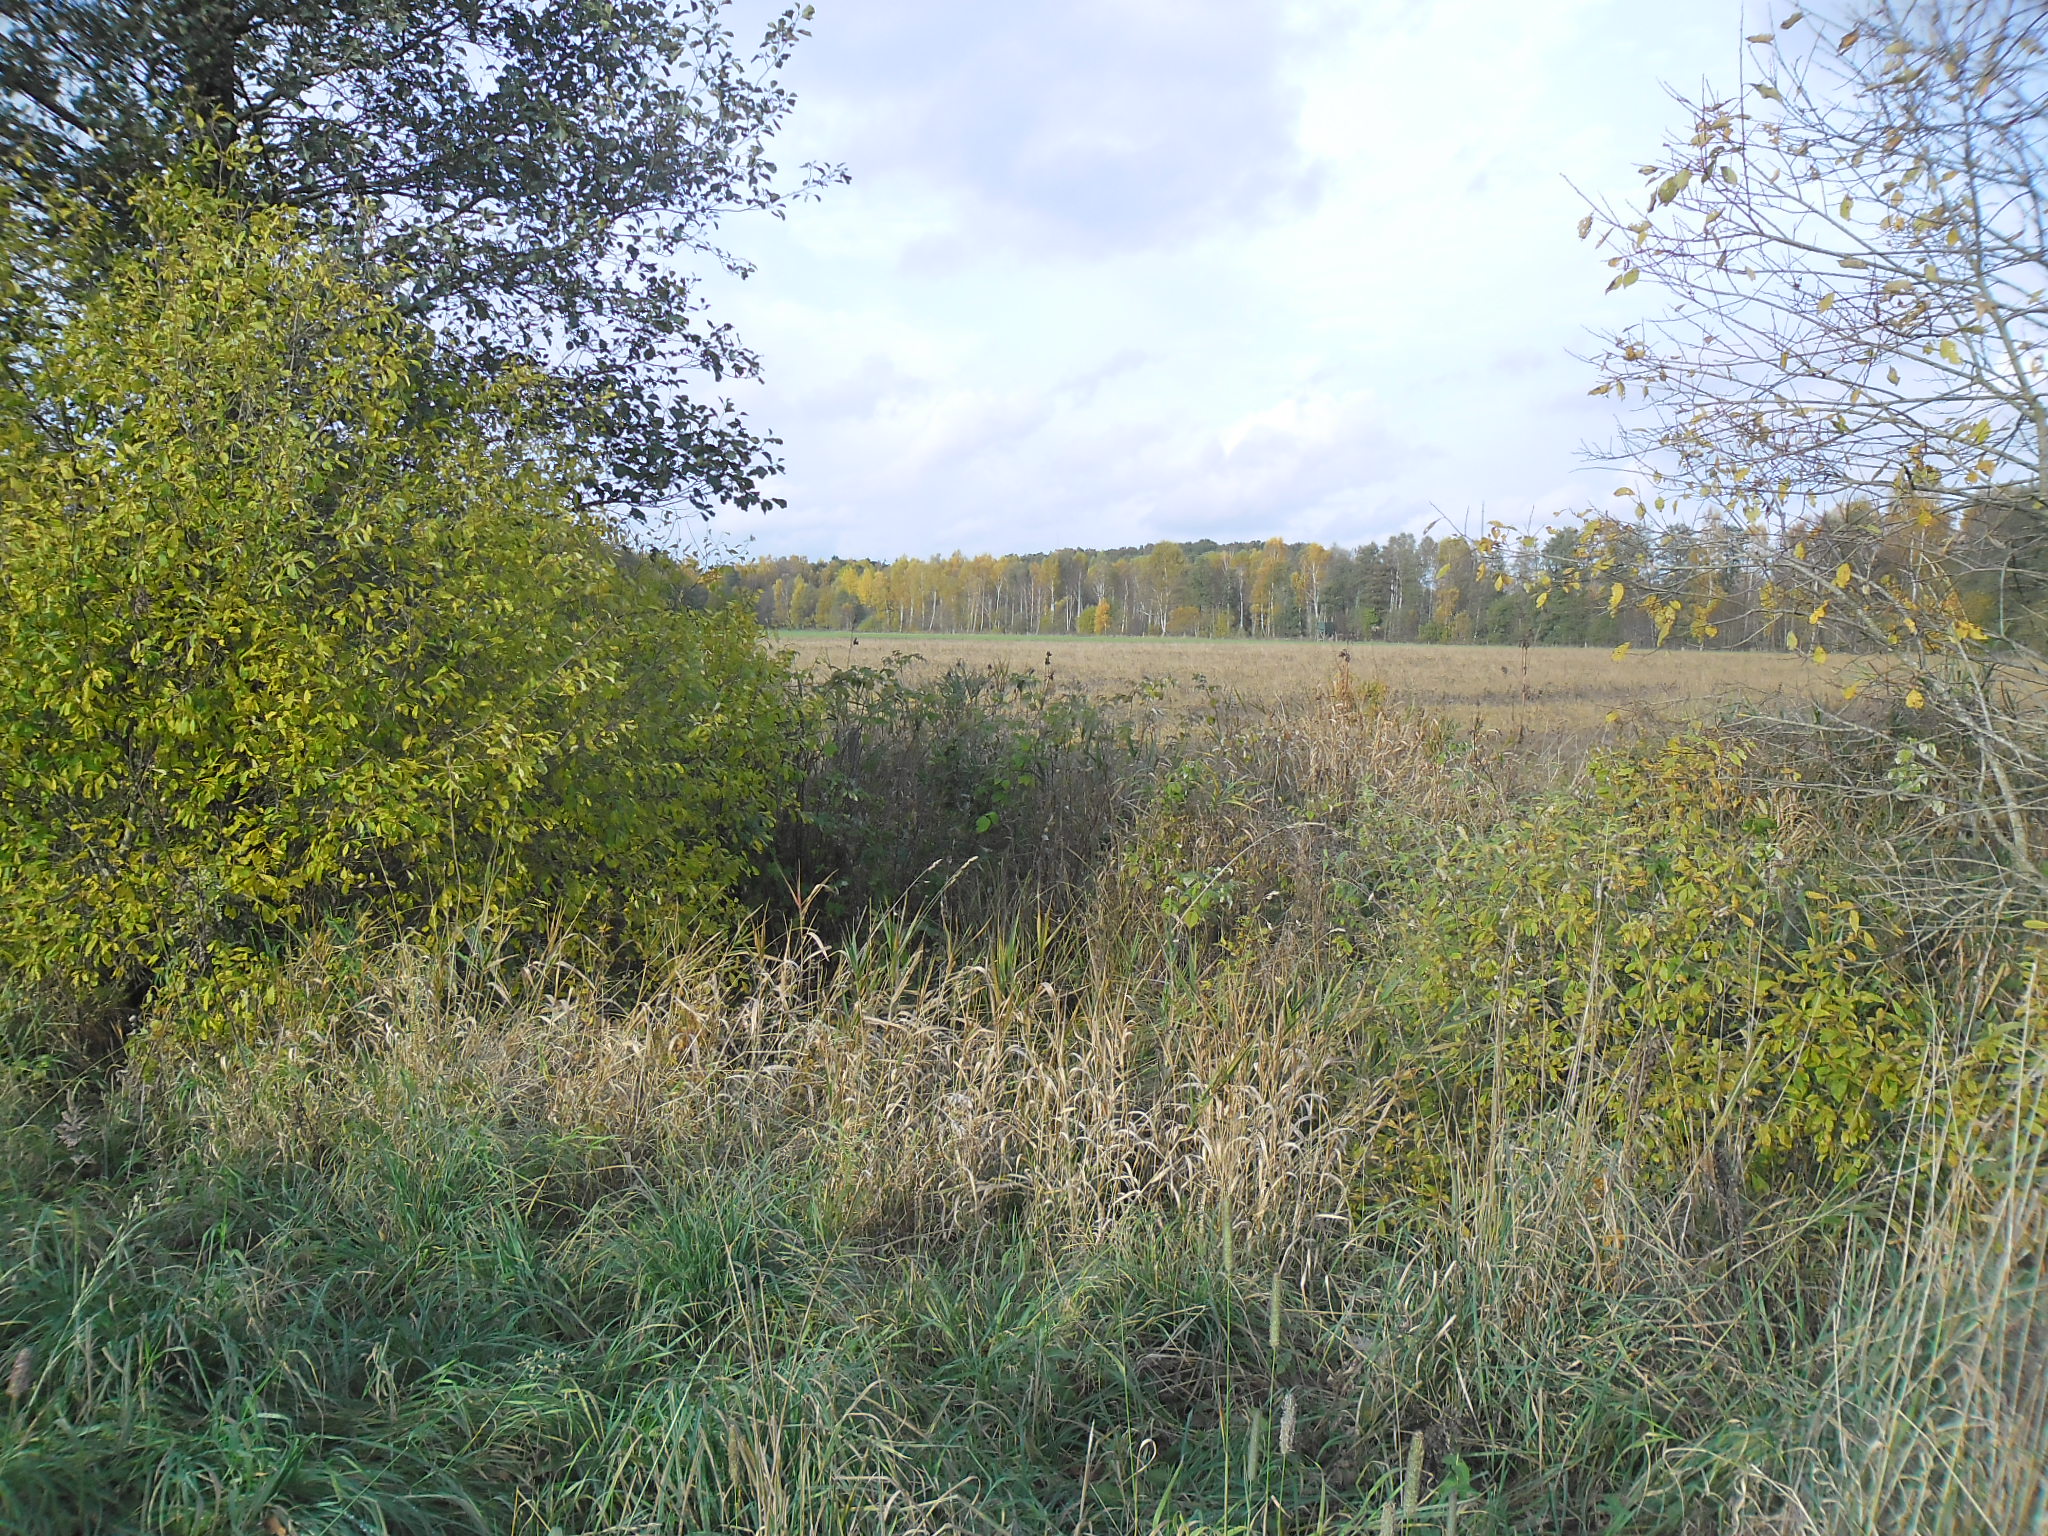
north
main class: Grassland
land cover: Grassland without tree/shrub cover
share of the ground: > 75 %
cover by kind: herbaceous plants 100 %
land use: Agriculture (excluding fallow land and kitchen gardens)
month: October
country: SE
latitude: 56.0613
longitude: 13.7397
